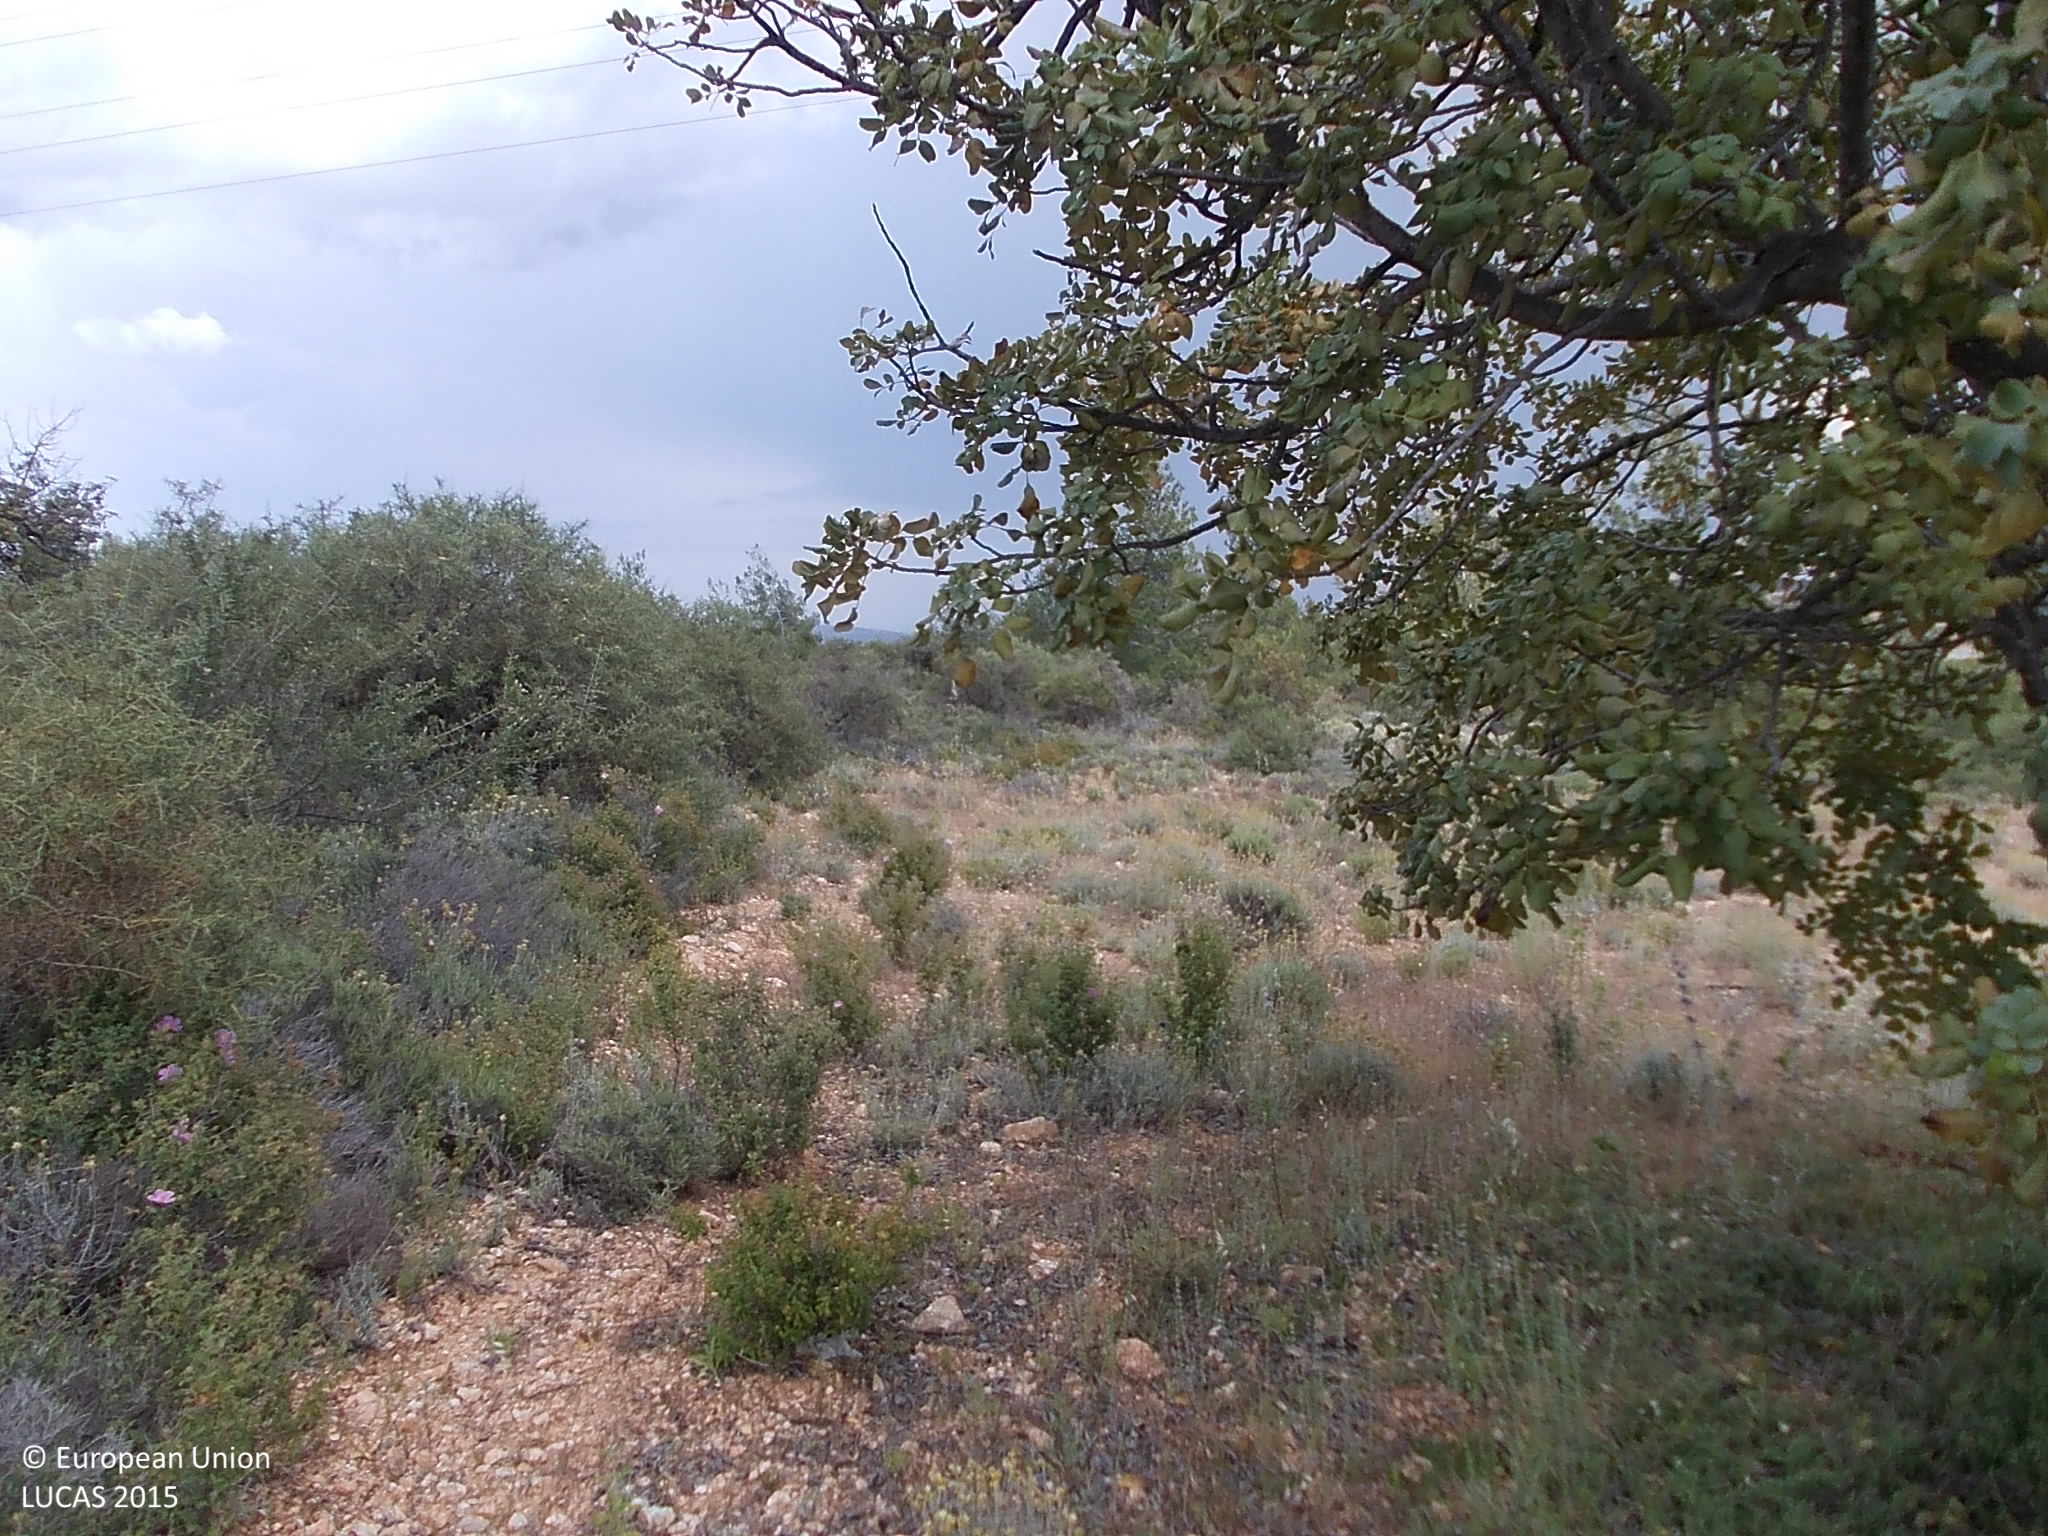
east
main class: Woodland
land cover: Broadleaved woodland
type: broadleaved evergreen forest
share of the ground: 10 - 25 %
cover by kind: herbaceous plants 30 %, broadleaved forest trees 25 %, unconsolidated bare surface 25 %, shrubs 20 %
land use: Semi-natural and natural areas not in use
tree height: > 5 m
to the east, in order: Broadleaved woodland; Shrubland without tree cover; Shrubland with sparse tree cover; Electric lines; Shrubland with sparse tree cover; Broadleaved woodland; Shrubland with sparse tree cover; Shrubland without tree cover; Paved roads, cycling and walking lanes
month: May
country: CY
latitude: 34.7531
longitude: 32.9399
